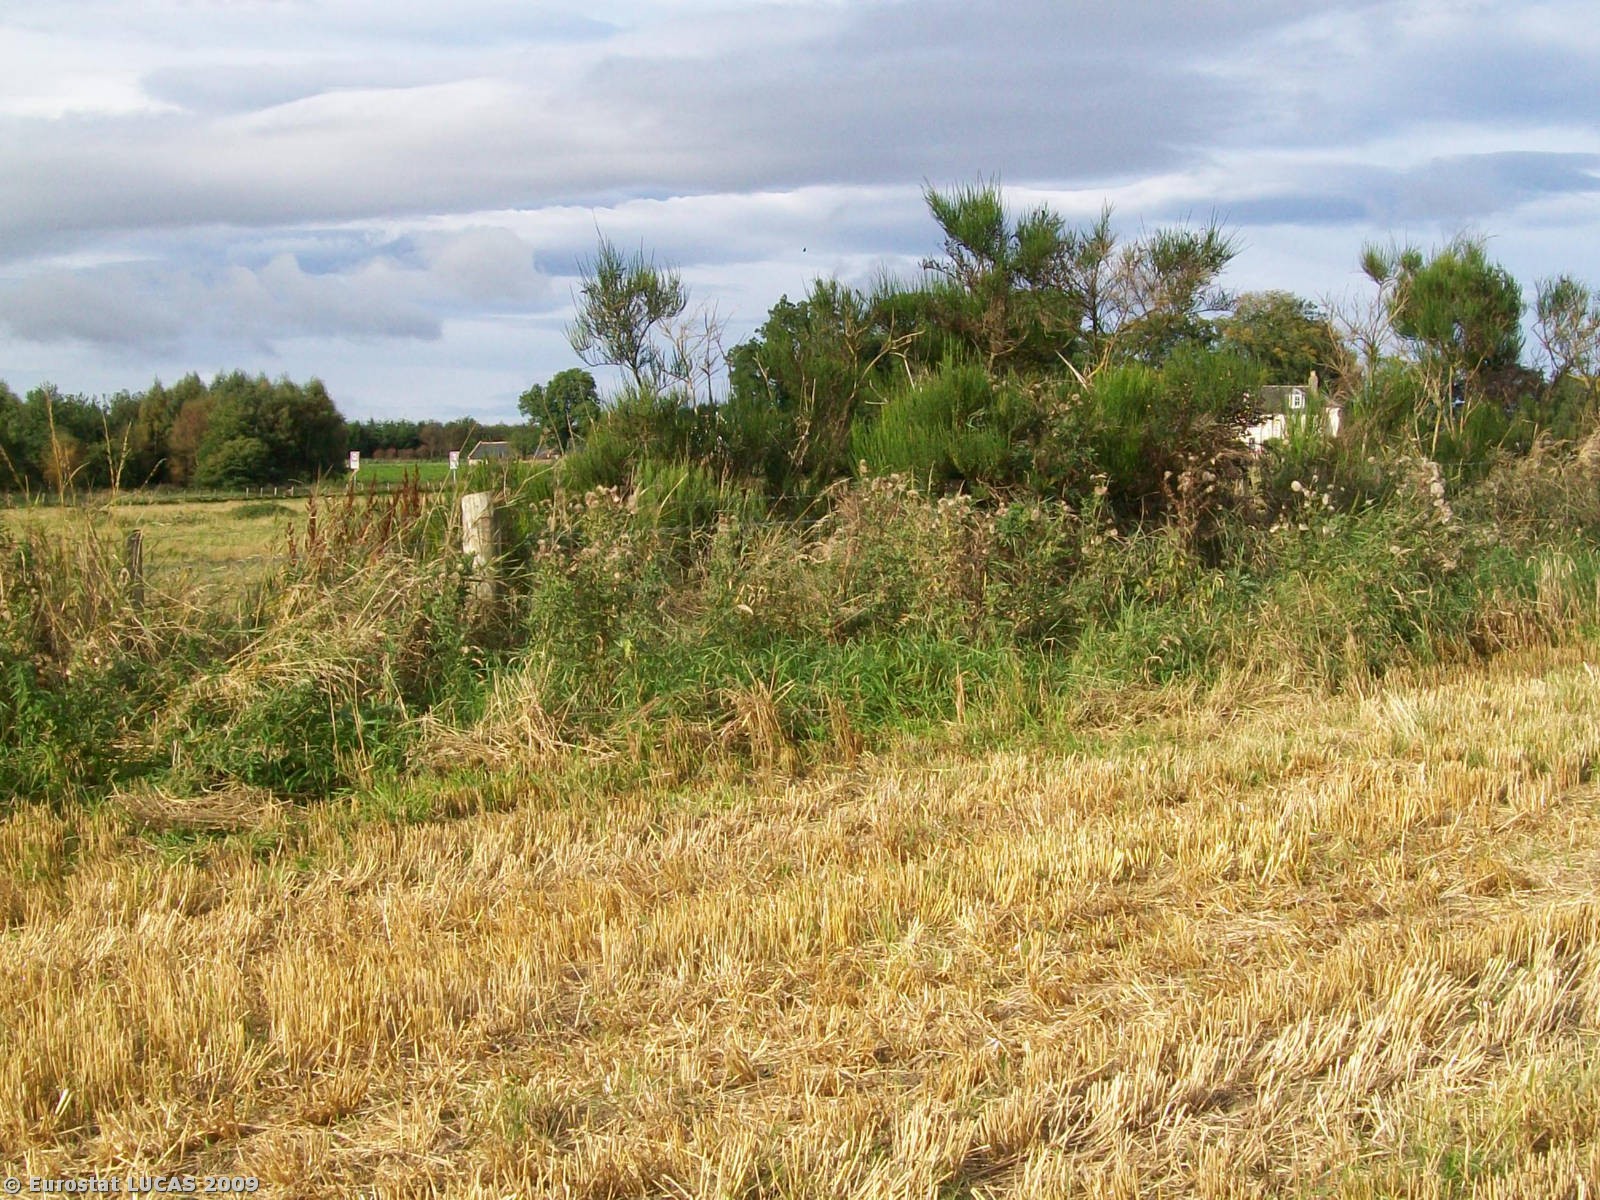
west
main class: Cropland
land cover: Barley
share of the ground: < 10 %
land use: Agriculture (excluding fallow land and kitchen gardens)
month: September
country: GB
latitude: 57.3207
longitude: -2.5250
